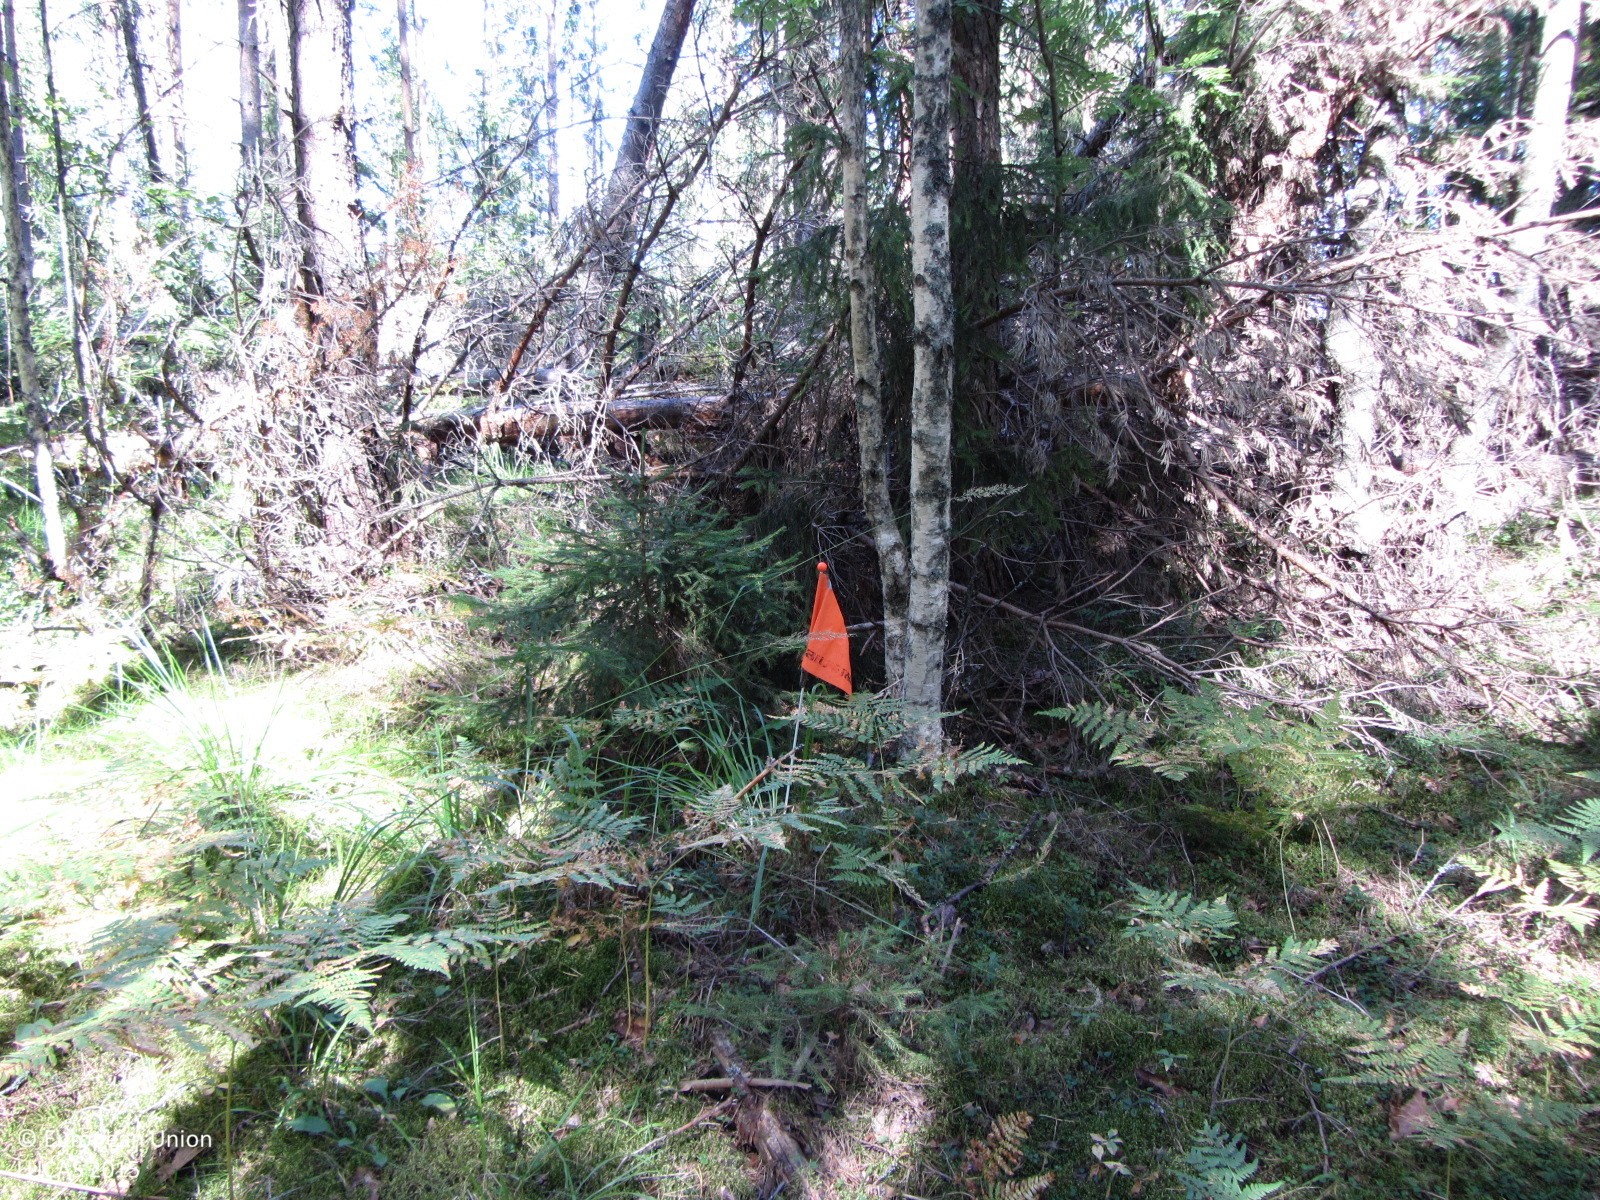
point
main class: Woodland
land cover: Pine dominated mixed woodland
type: boreal forest
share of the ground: > 75 %
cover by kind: coniferous forest trees 60 %, broadleaved forest trees 25 %, herbaceous plants 10 %, lichens and mosses 5 %
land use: Forestry
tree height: > 5 m
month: August
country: FI
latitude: 60.5052
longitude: 23.9889
